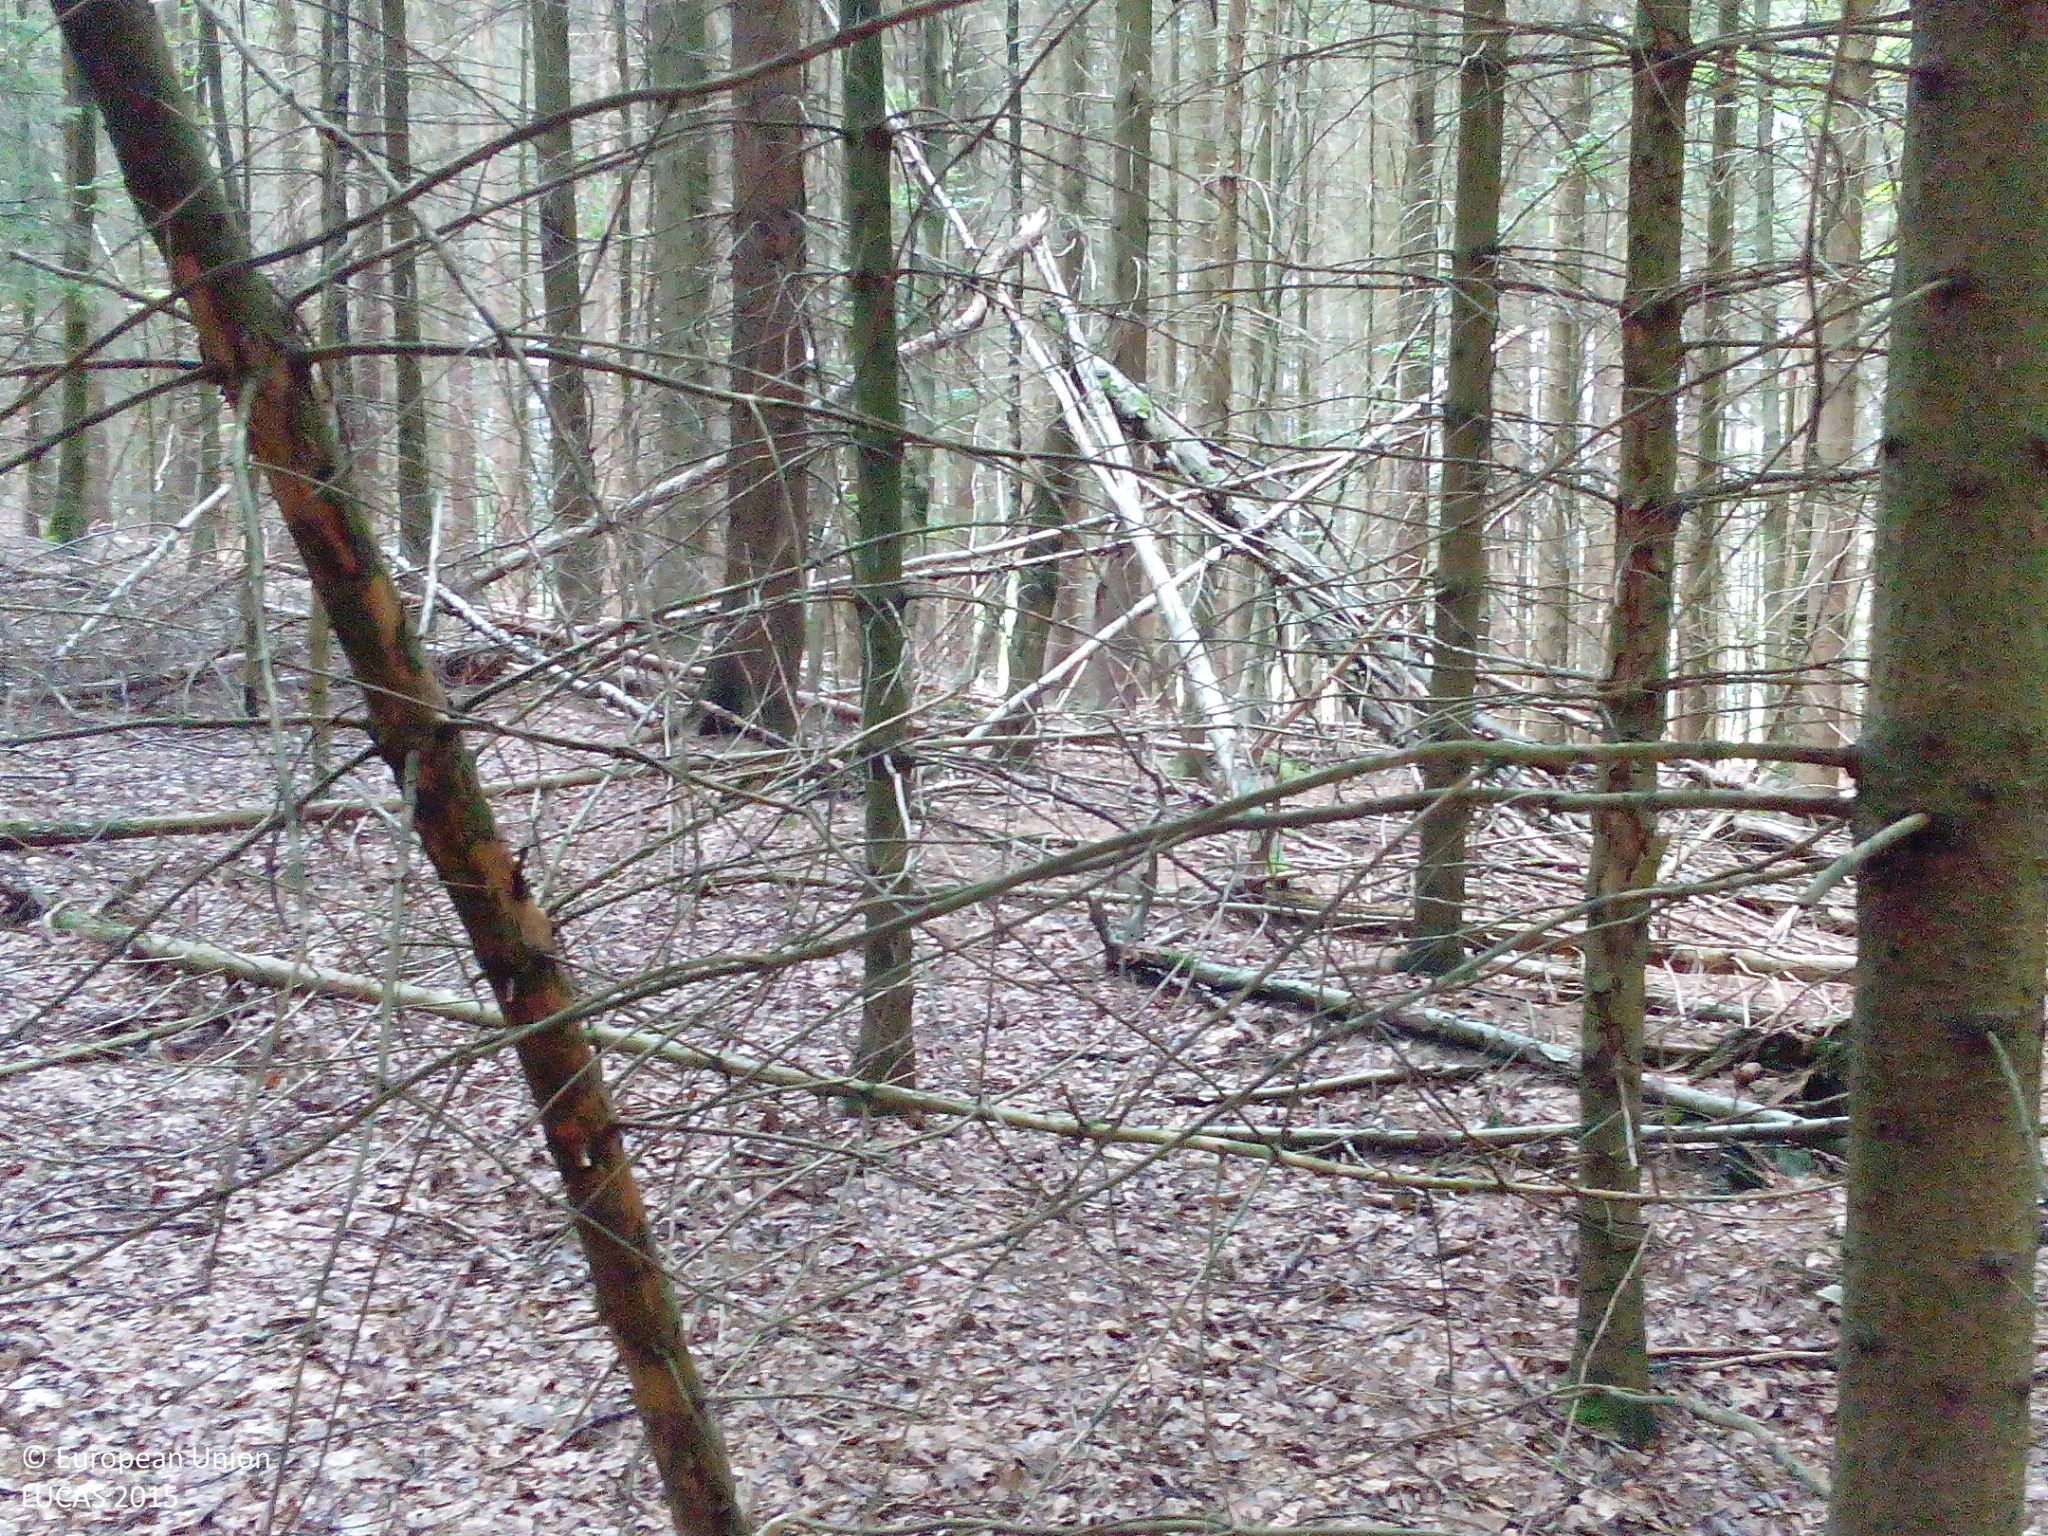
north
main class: Woodland
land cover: Spruce dominated mixed woodland
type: hemiboreal forest and nemoral coniferous forest and mixed broadleaved-coniferous forest
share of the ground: > 75 %
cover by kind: coniferous forest trees 70 %, broadleaved forest trees 30 %
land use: Forestry
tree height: > 5 m
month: July
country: DE
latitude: 50.5438
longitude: 9.9295
